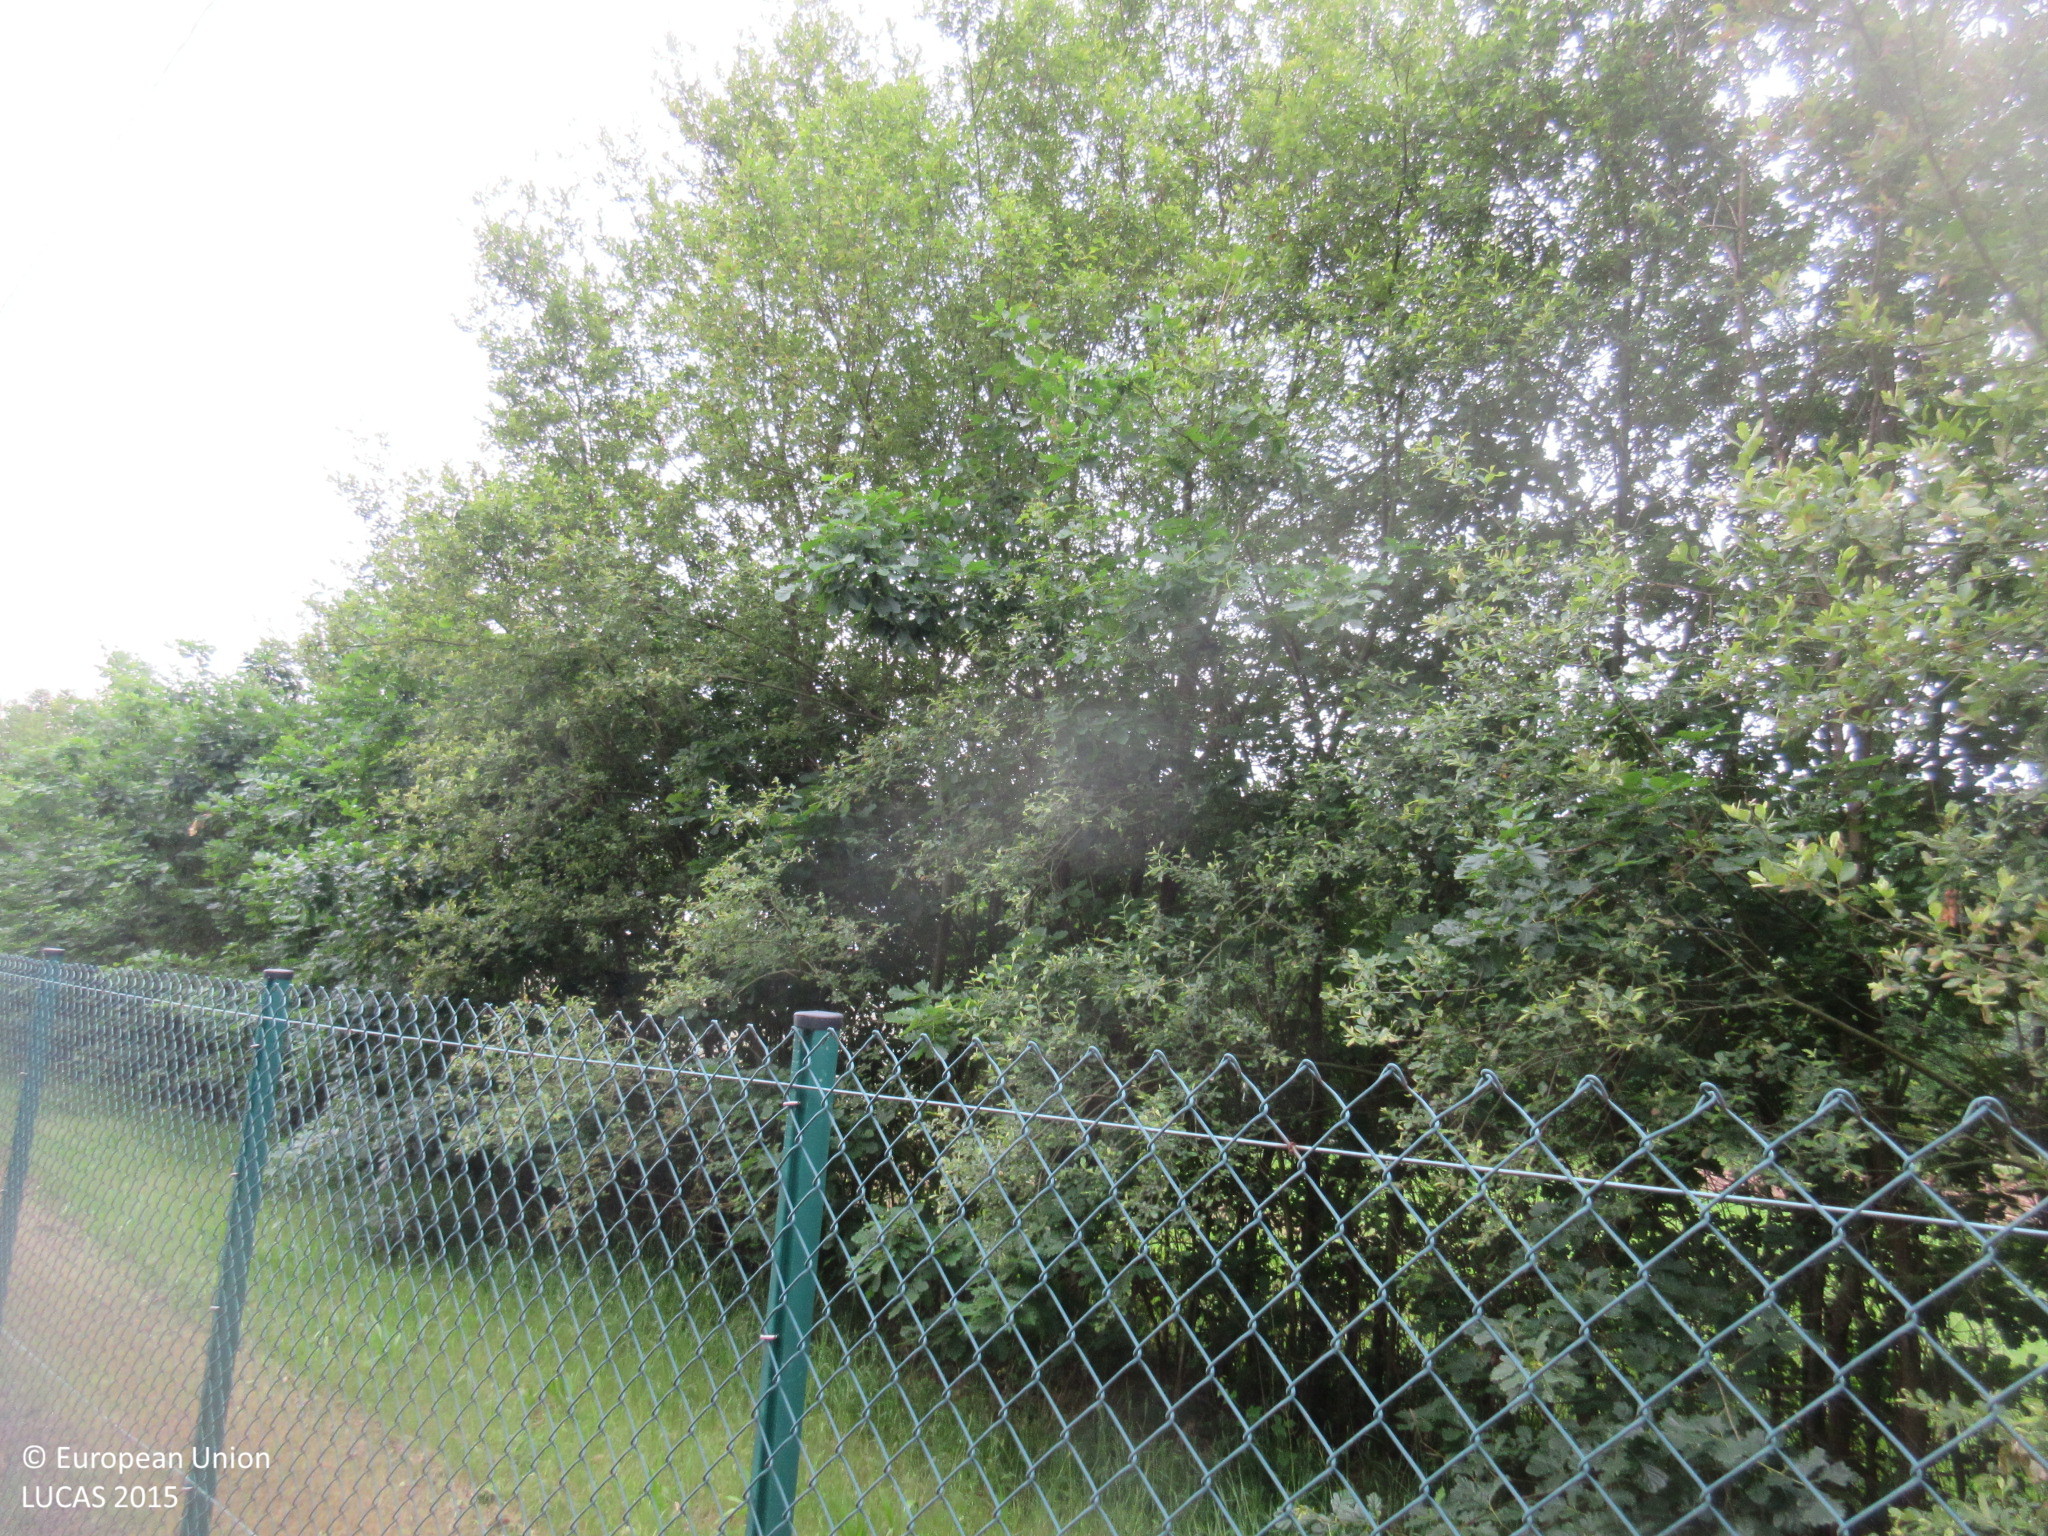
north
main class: Grassland
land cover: Grassland without tree/shrub cover
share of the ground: > 75 %
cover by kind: herbaceous plants 100 %
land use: Agriculture (excluding fallow land and kitchen gardens)
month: June
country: ES
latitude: 43.3594
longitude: -4.1323
